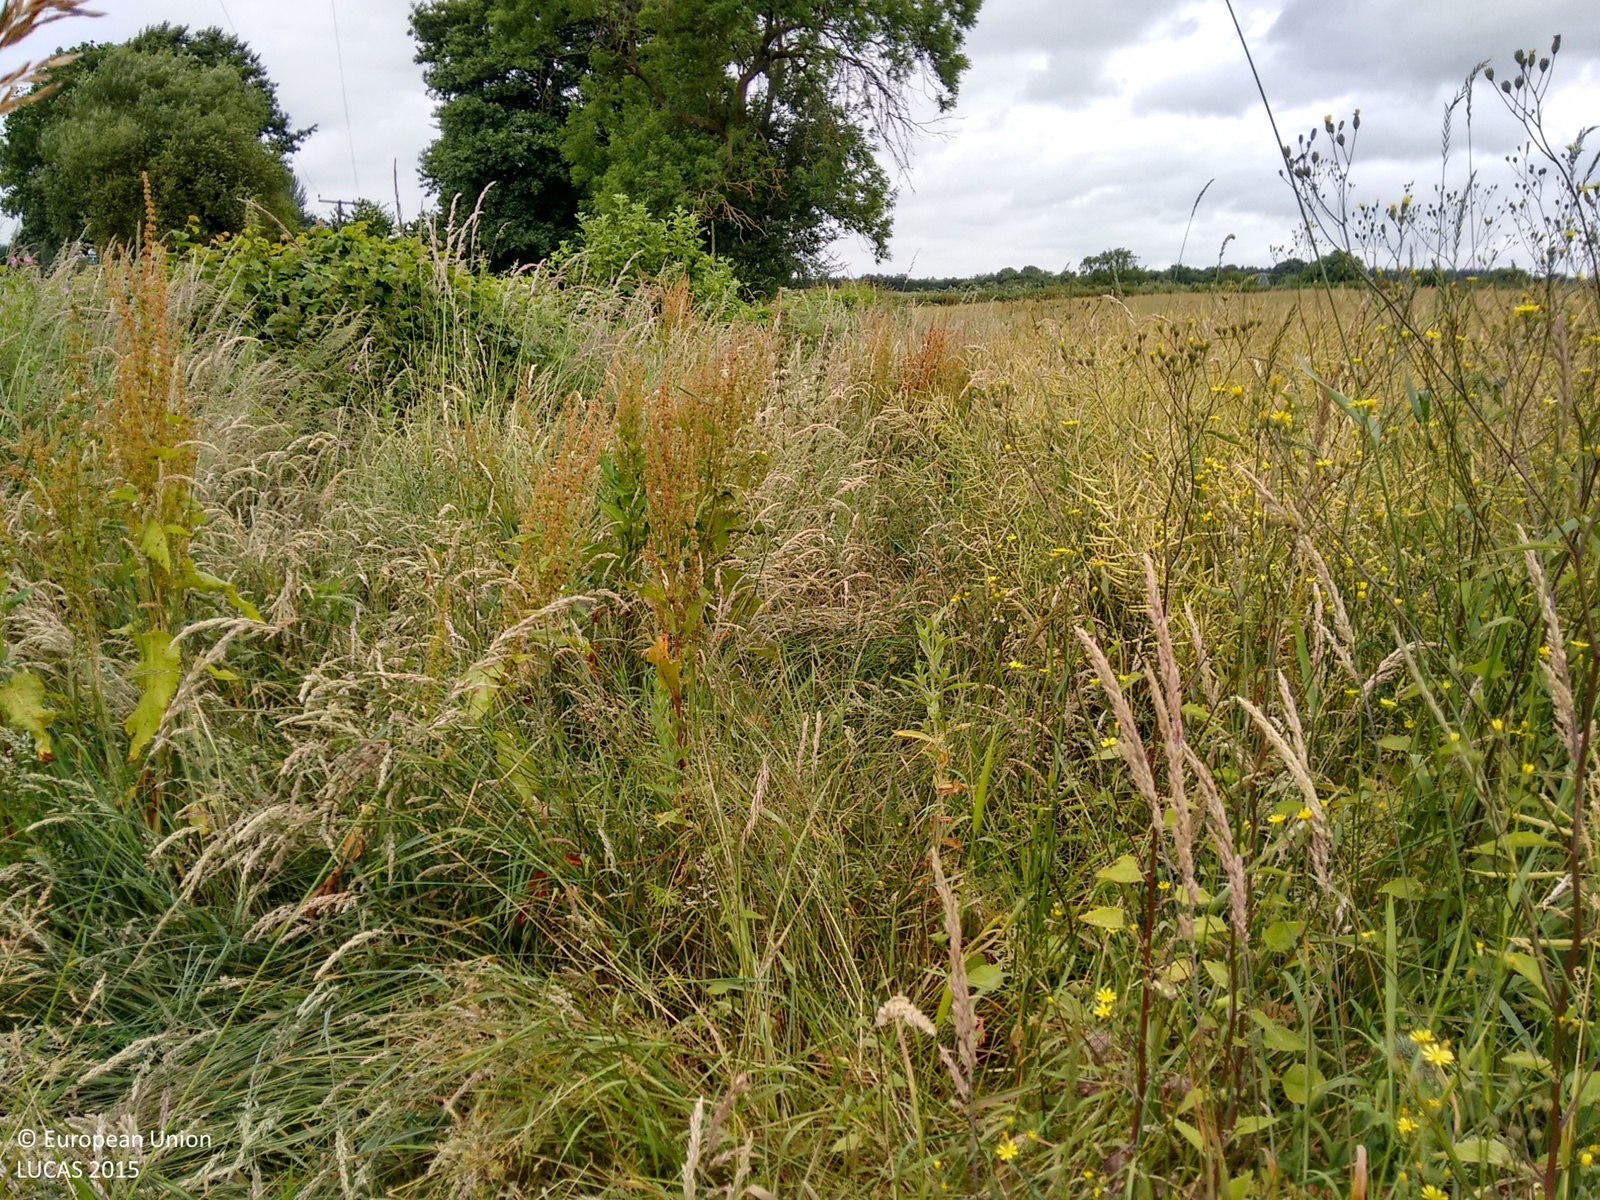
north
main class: Cropland
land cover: Rape and turnip rape
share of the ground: > 75 %
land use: Agriculture (excluding fallow land and kitchen gardens)
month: July
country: GB
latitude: 52.0555
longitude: -2.5363
